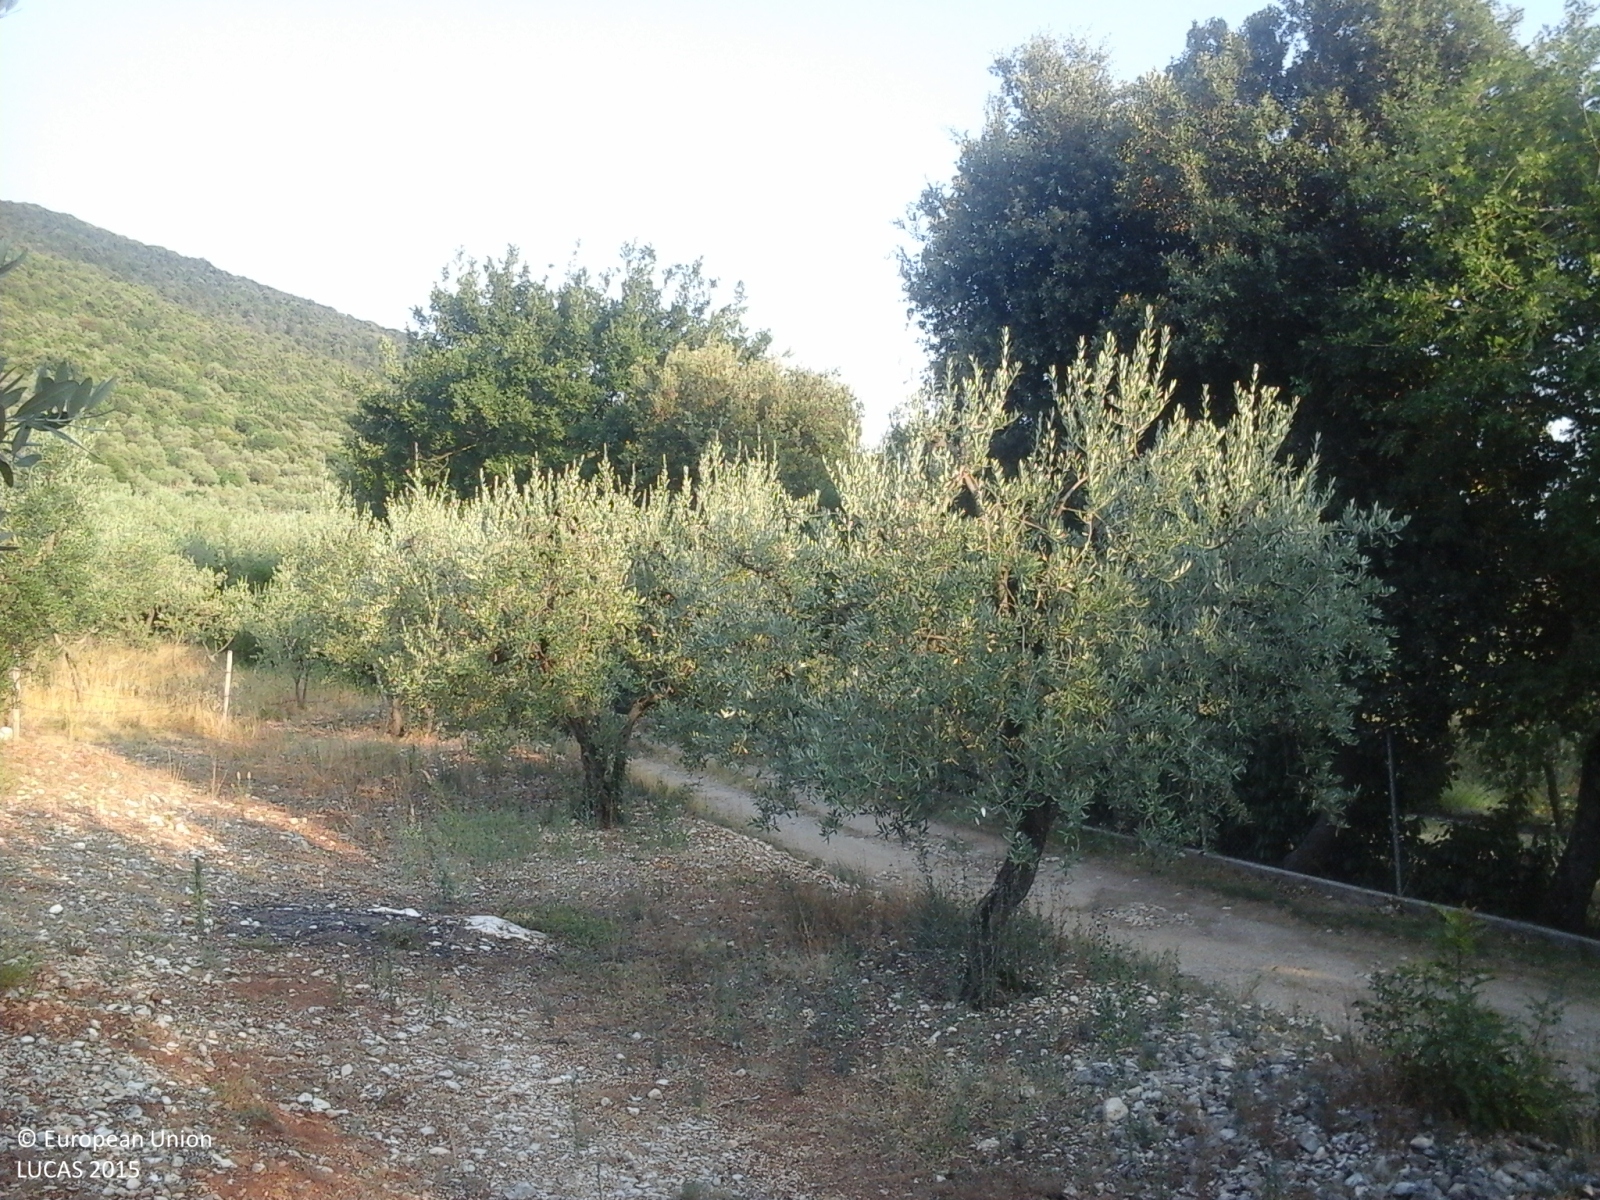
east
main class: Cropland
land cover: Olive groves
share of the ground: 50 - 75 %
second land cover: Spontaneously vegetated surfaces
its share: 25 - 50 %
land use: Agriculture (excluding fallow land and kitchen gardens)
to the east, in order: Olive groves; Spontaneously vegetated surfaces; Tracks; Olive groves; Tracks; Olive groves
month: August
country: IT
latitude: 42.5727
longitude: 12.3436
